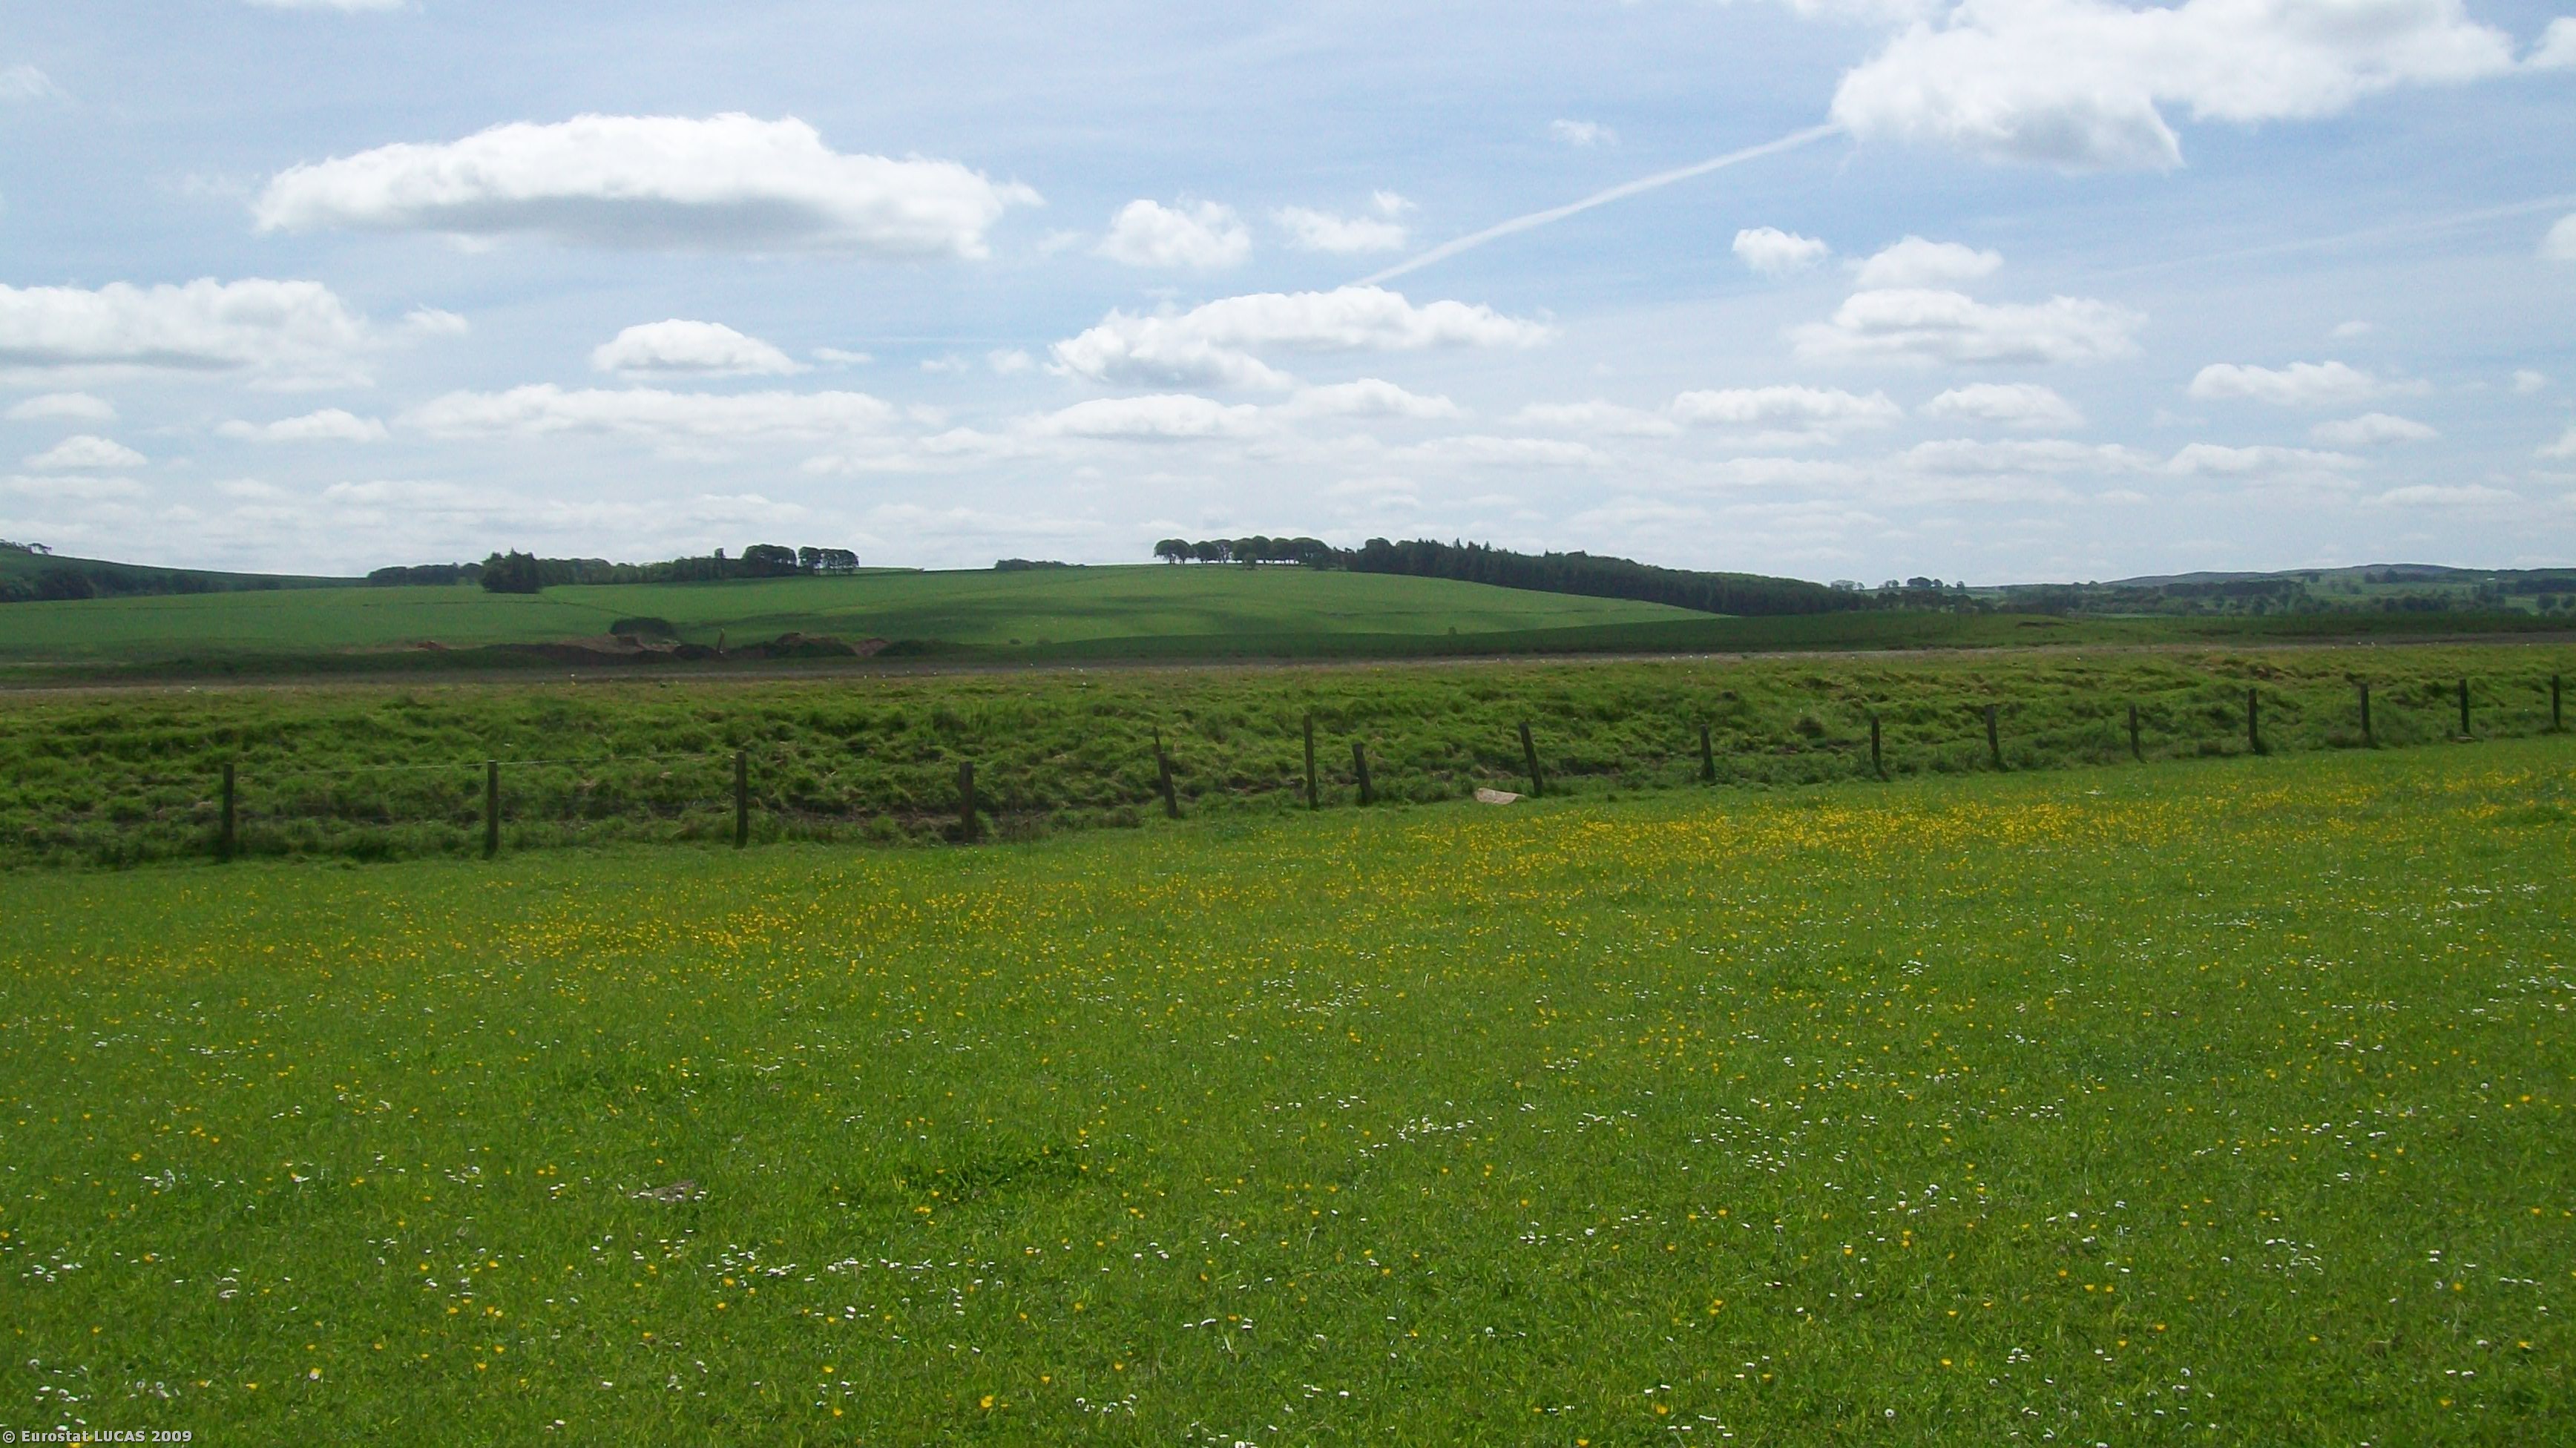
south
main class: Grassland
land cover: Grassland without tree/shrub cover
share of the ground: > 75 %
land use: Agriculture (excluding fallow land and kitchen gardens)
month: June
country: GB
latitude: 55.7045
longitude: -3.5256
